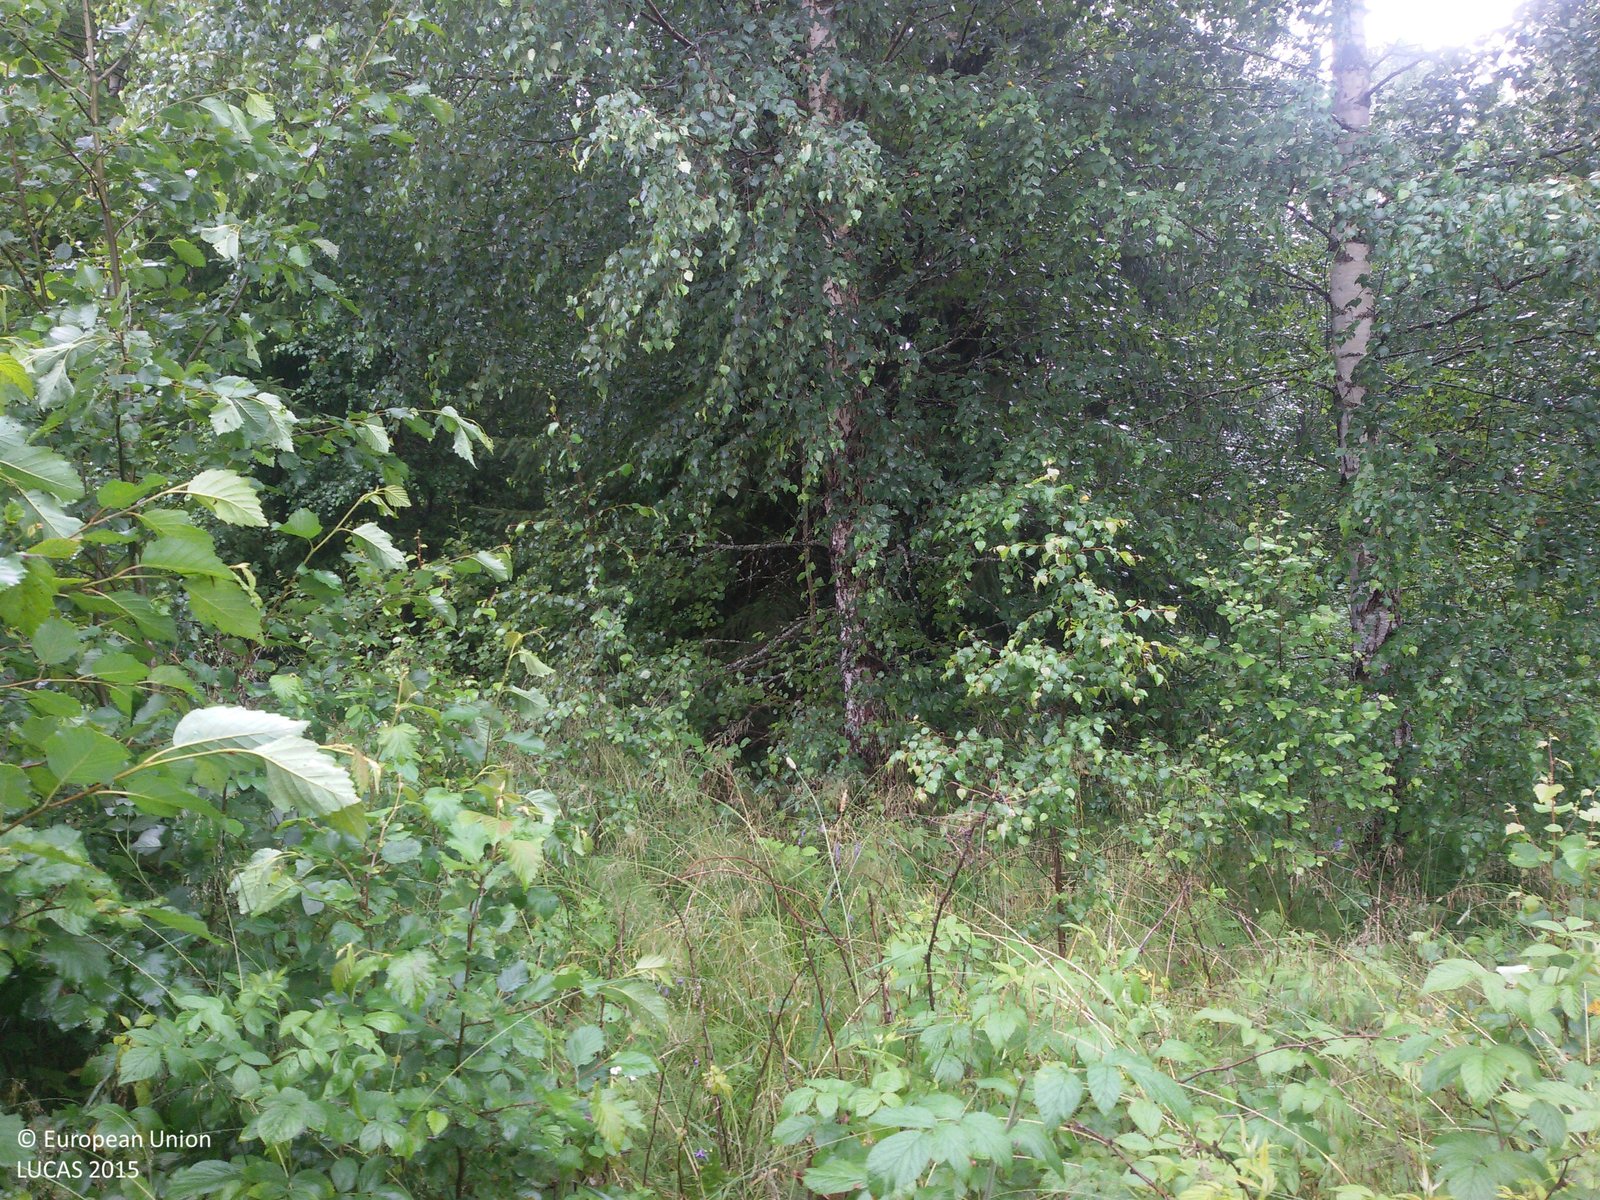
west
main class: Shrubland
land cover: Shrubland with sparse tree cover
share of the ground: > 75 %
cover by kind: shrubs 85 %, herbaceous plants 10 %, coniferous forest trees 5 %
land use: Electricity, gas and thermal power distribution
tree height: < 5 m
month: July
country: SE
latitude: 60.5488
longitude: 15.8039
